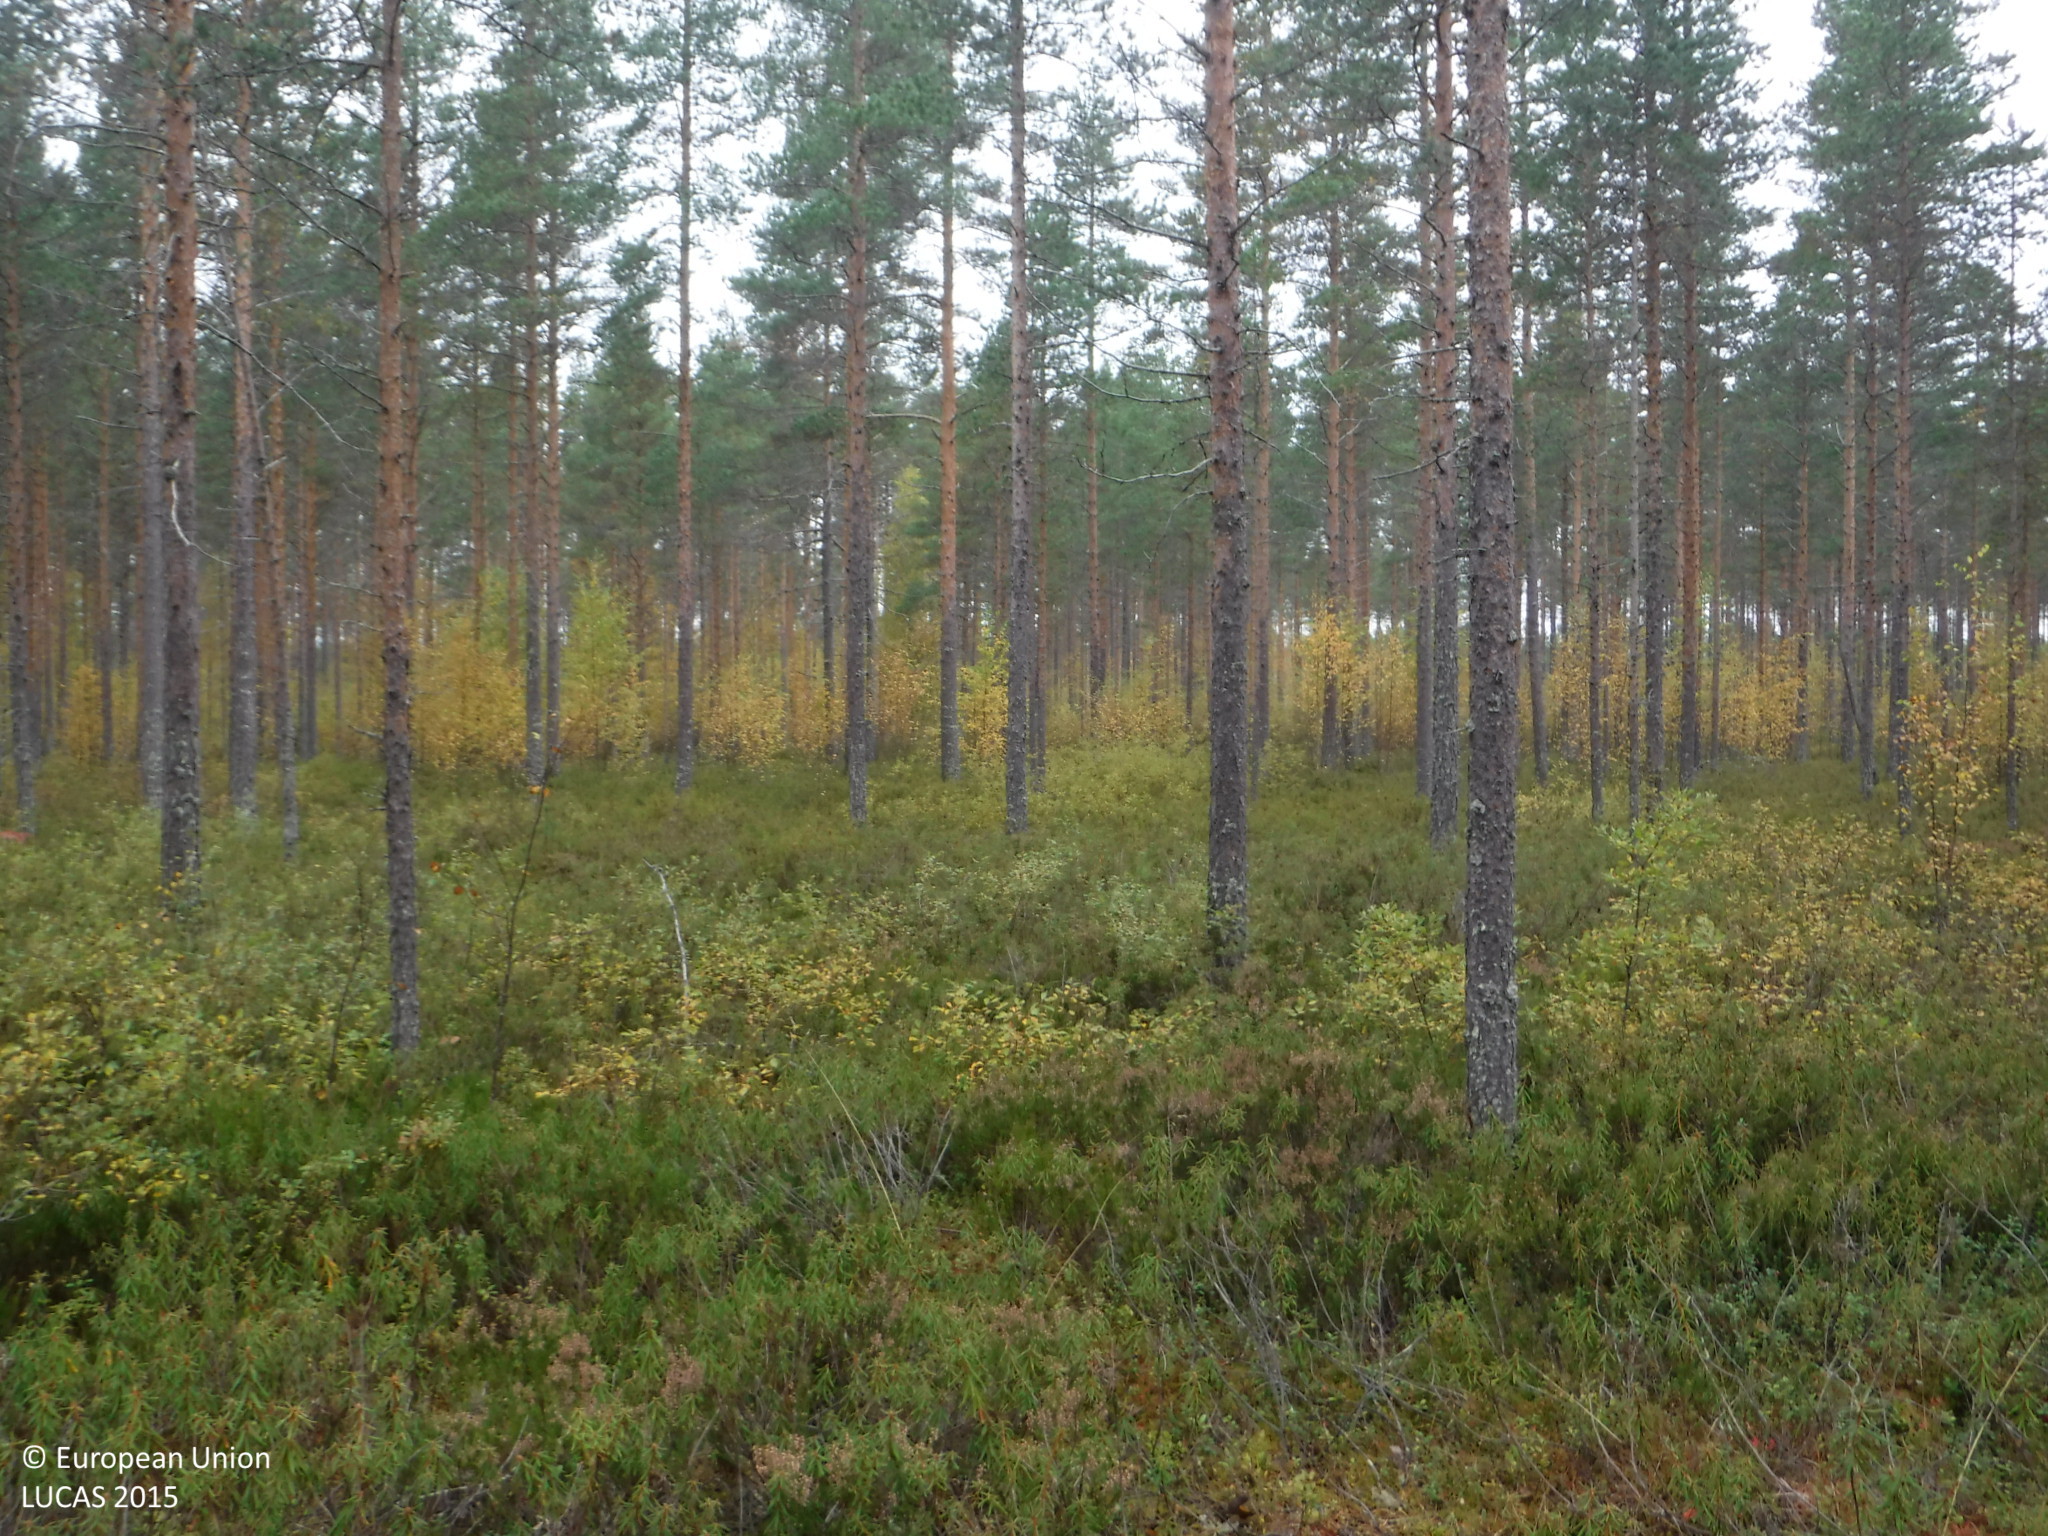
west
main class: Woodland
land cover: Pine dominated coniferous woodland
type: boreal forest
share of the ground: 25 - 50 %
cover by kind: shrubs 50 %, coniferous forest trees 30 %, lichens and mosses 20 %
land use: Forestry
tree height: > 5 m
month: September
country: FI
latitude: 62.0866
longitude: 22.9524
